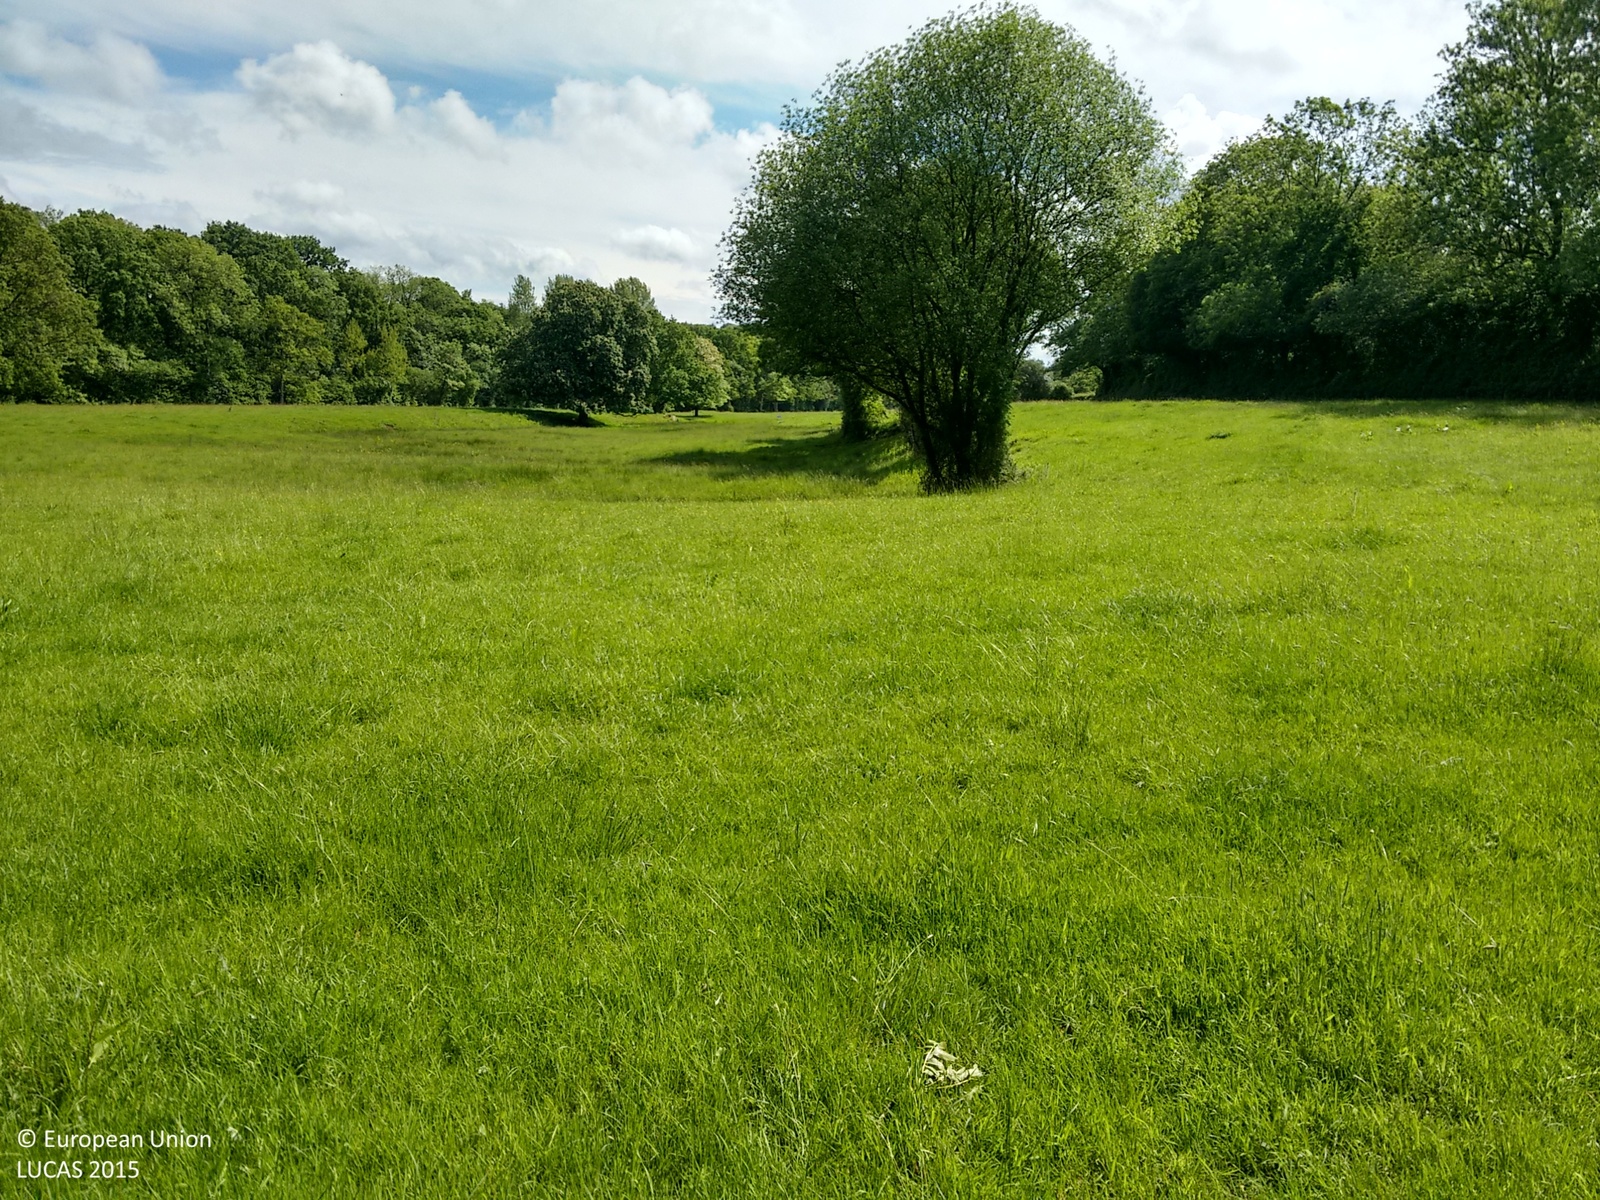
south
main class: Woodland
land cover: Broadleaved woodland
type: mesophytic deciduous forest
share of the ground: > 75 %
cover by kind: broadleaved forest trees 100 %
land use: Forestry
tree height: > 5 m
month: May
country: GB
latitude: 51.0108
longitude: -1.3806
